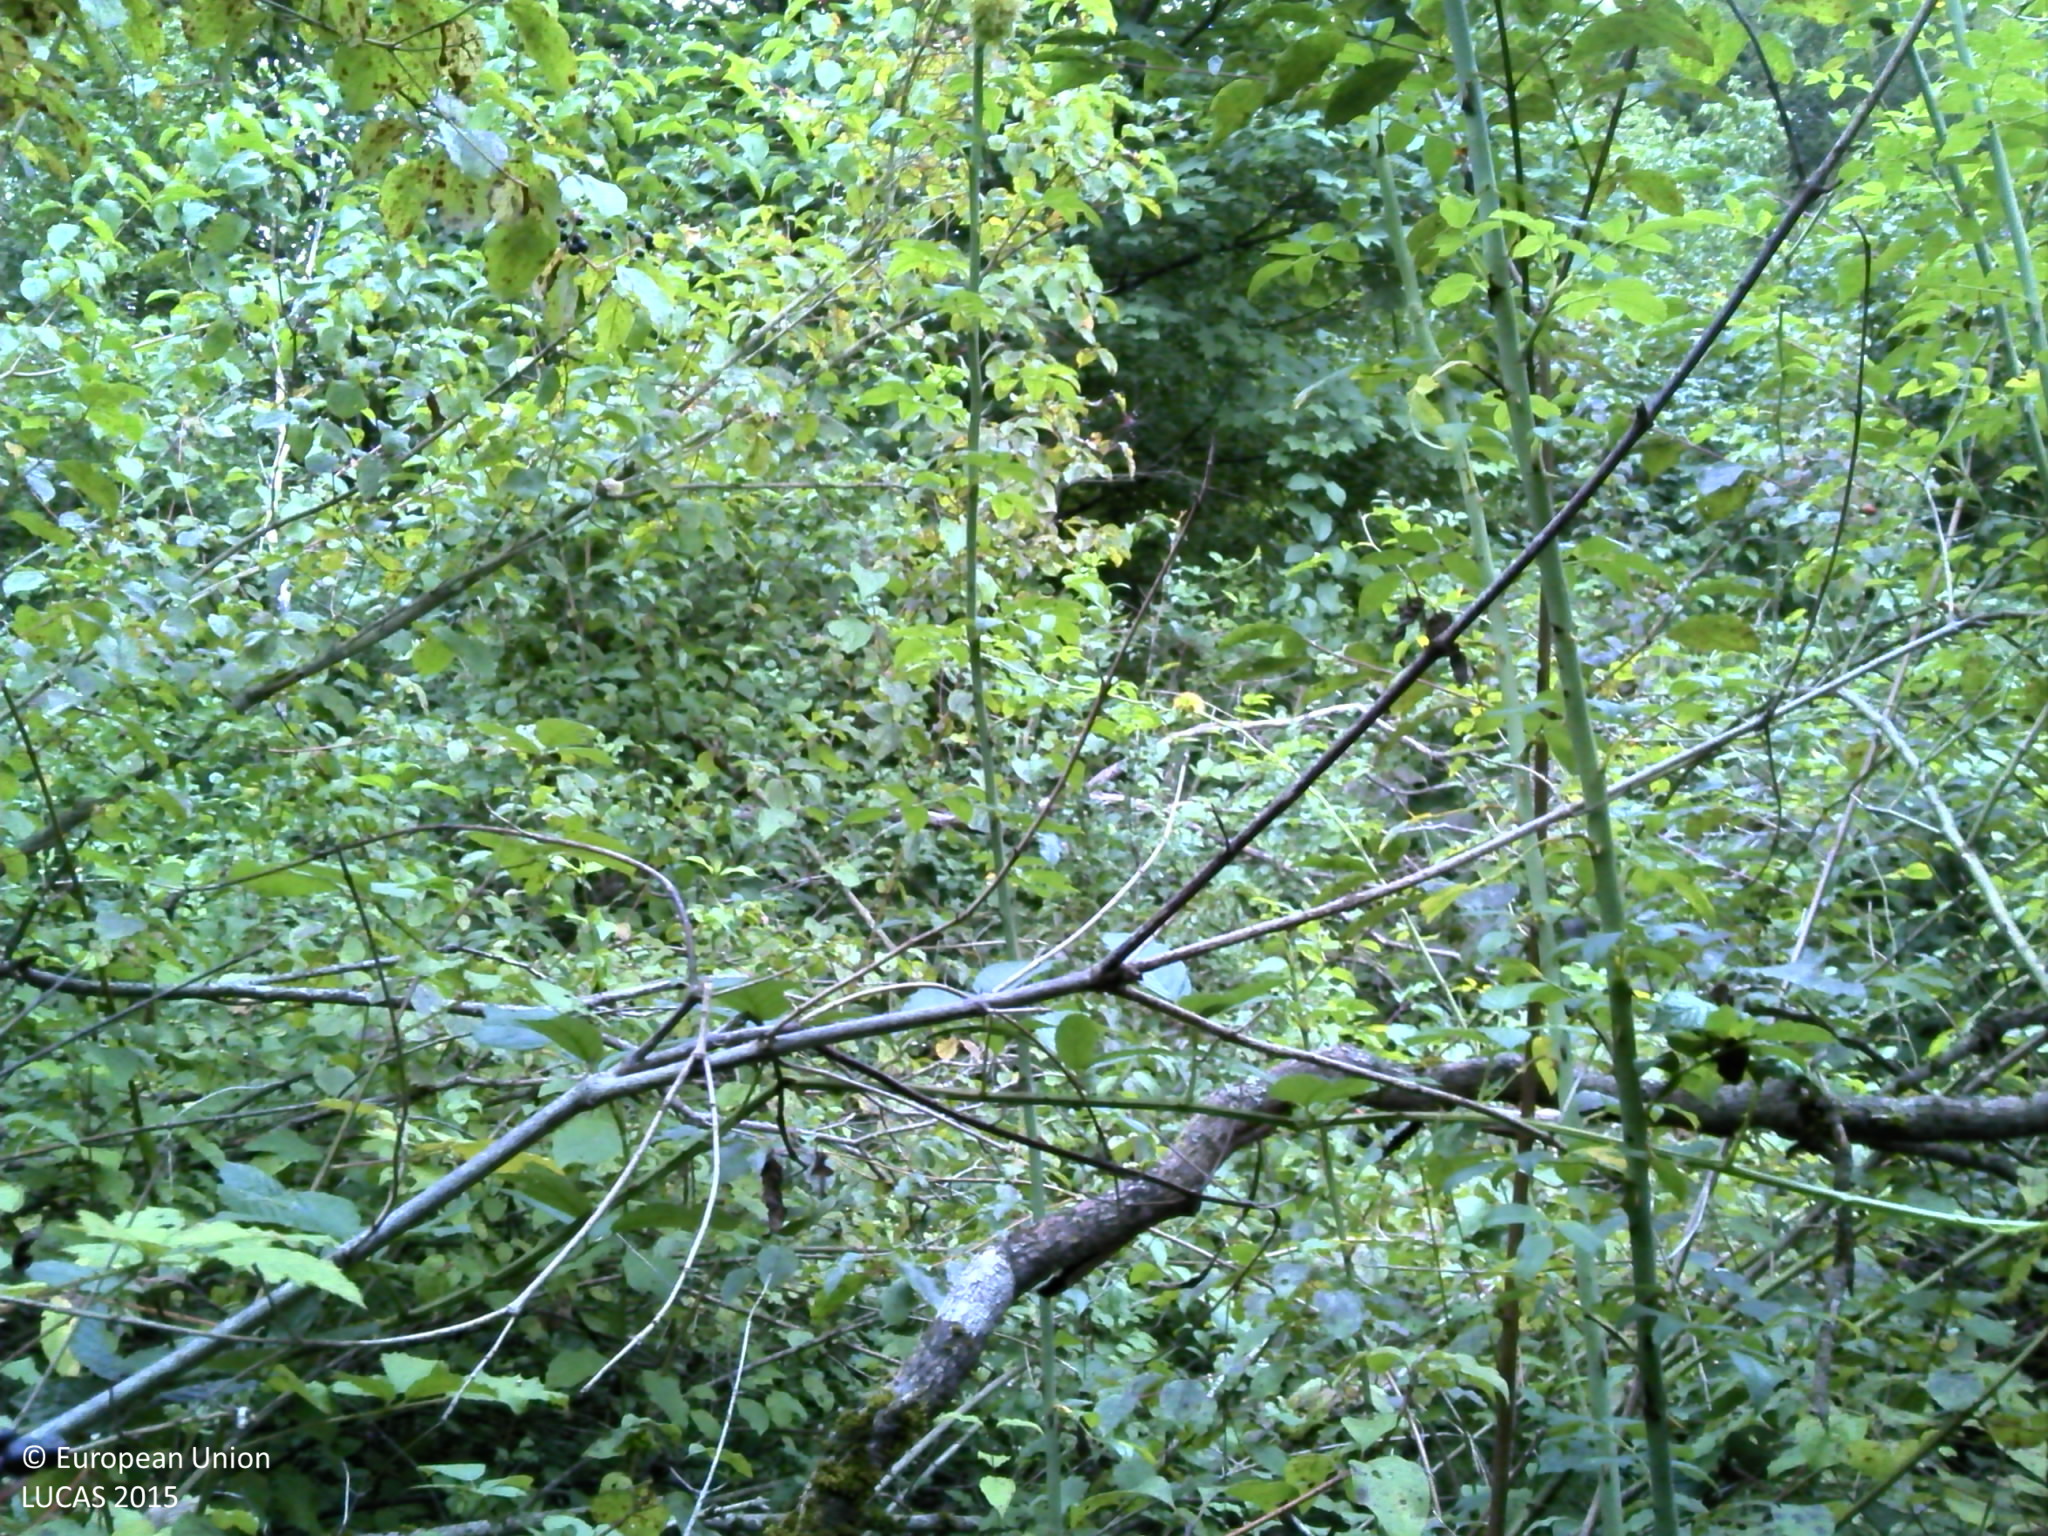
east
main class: Woodland
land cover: Broadleaved woodland
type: mesophytic deciduous forest
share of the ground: > 75 %
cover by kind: broadleaved forest trees 100 %
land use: Forestry
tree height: > 5 m
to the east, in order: Broadleaved woodland; Grassland without tree/shrub cover; Tracks; Fences; Grassland without tree/shrub cover
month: August
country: HR
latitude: 45.3185
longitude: 15.6216
